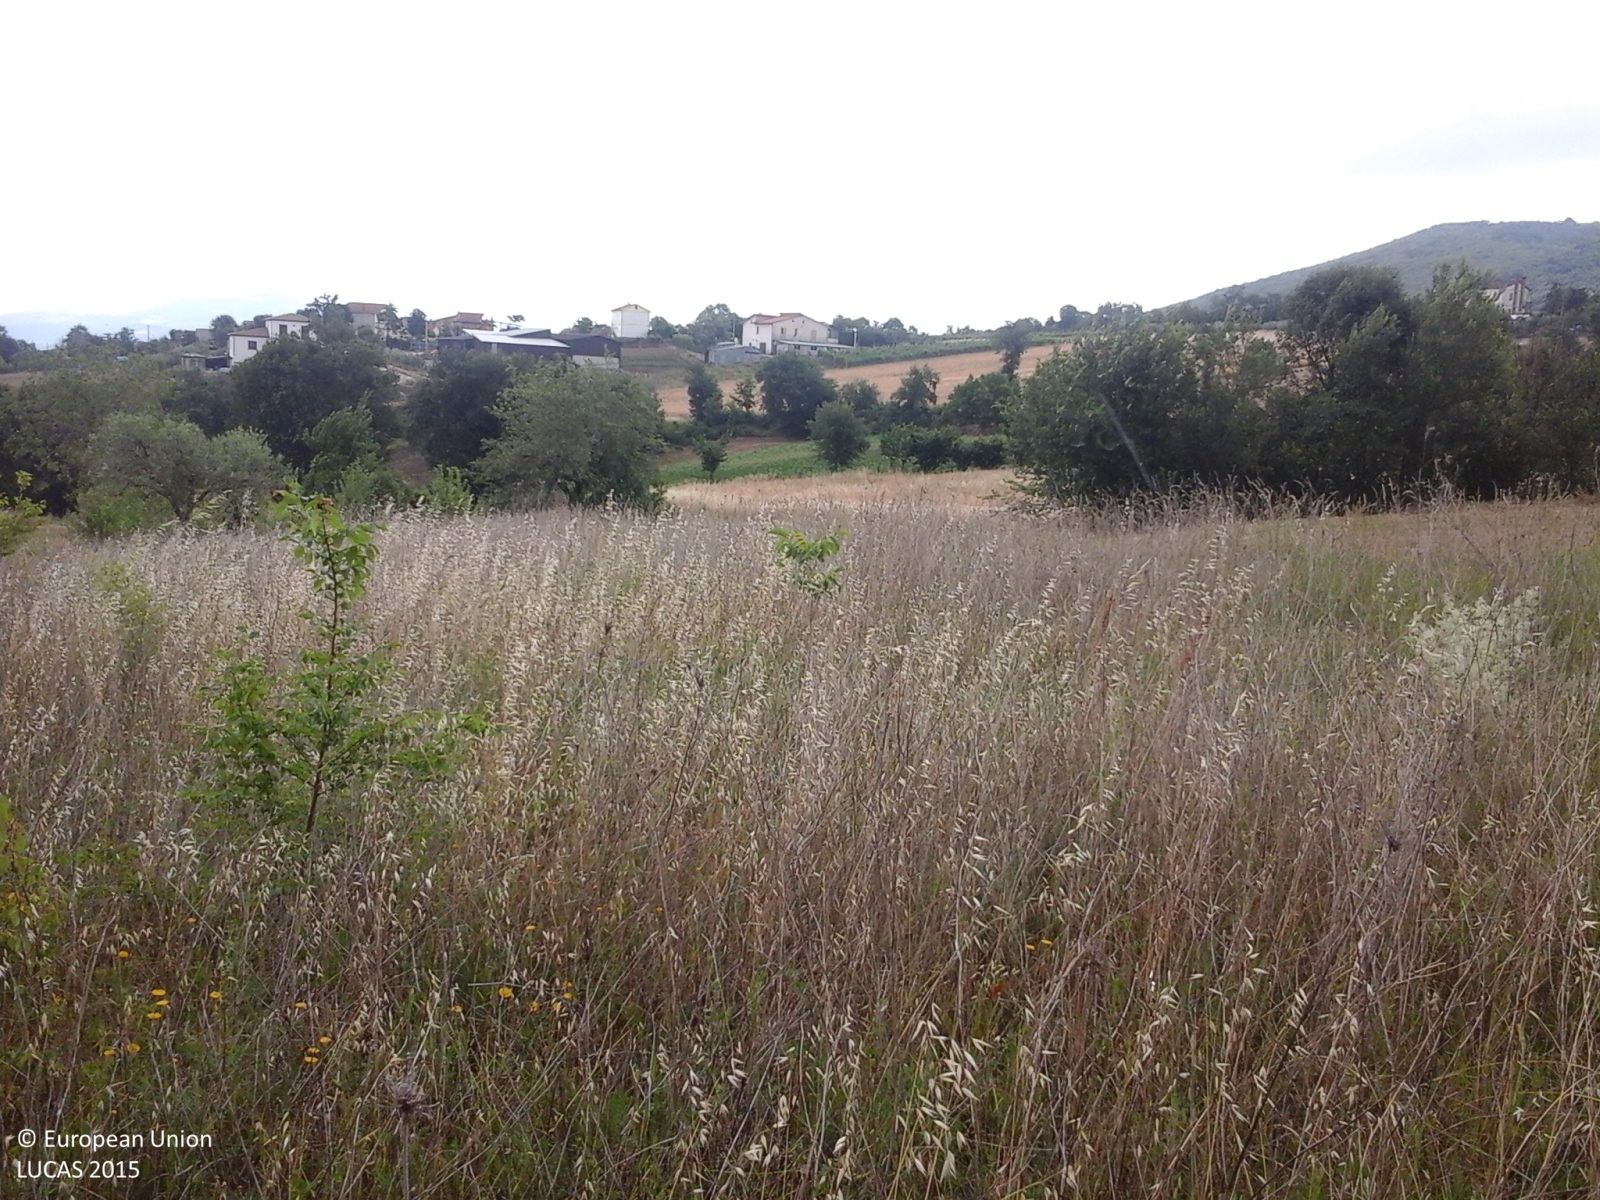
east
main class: Shrubland
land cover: Shrubland without tree cover
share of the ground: 50 - 75 %
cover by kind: shrubs 60 %, herbaceous plants 40 %
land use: Fallow land
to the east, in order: Shrubland without tree cover; Tracks; Single bushes/trees; Other bare soil; Single bushes/trees; Ditches and canals; Dry pulses; Potatoes; Single bushes/trees; Maize; Other bare soil; Broadleaved woodland; Other fruit trees and berries; Abandoned hedges; Common wheat
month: June
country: IT
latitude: 41.0237
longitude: 15.0828
